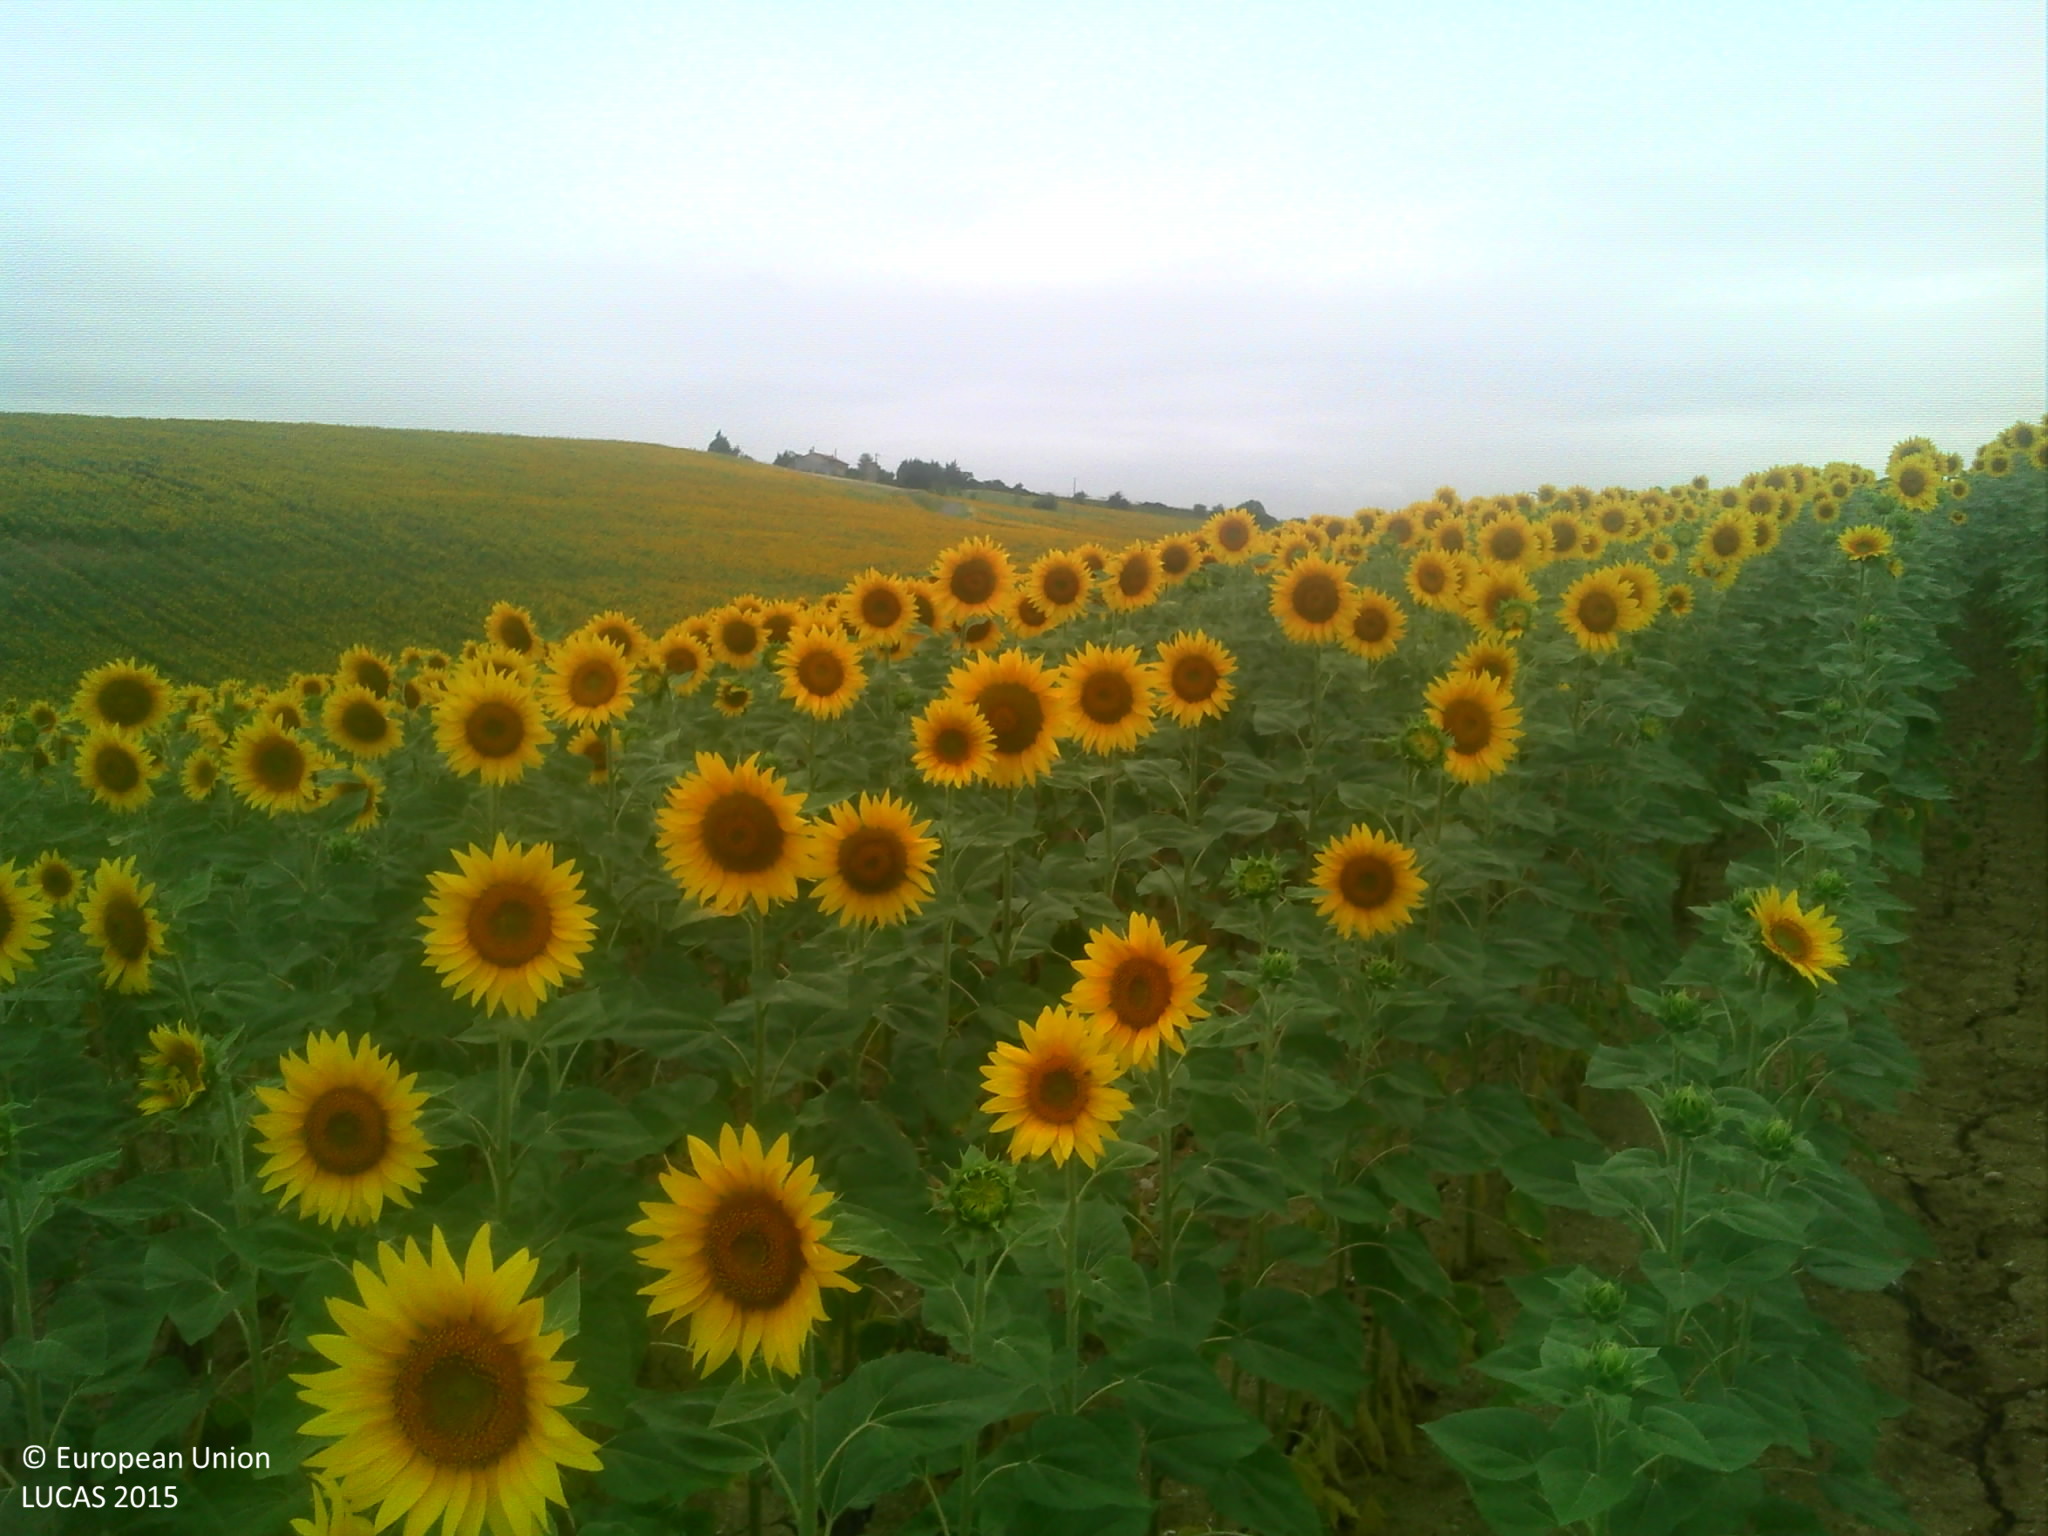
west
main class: Cropland
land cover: Sunflower
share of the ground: > 75 %
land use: Agriculture (excluding fallow land and kitchen gardens)
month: July
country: FR
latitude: 43.2194
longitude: 1.4736
